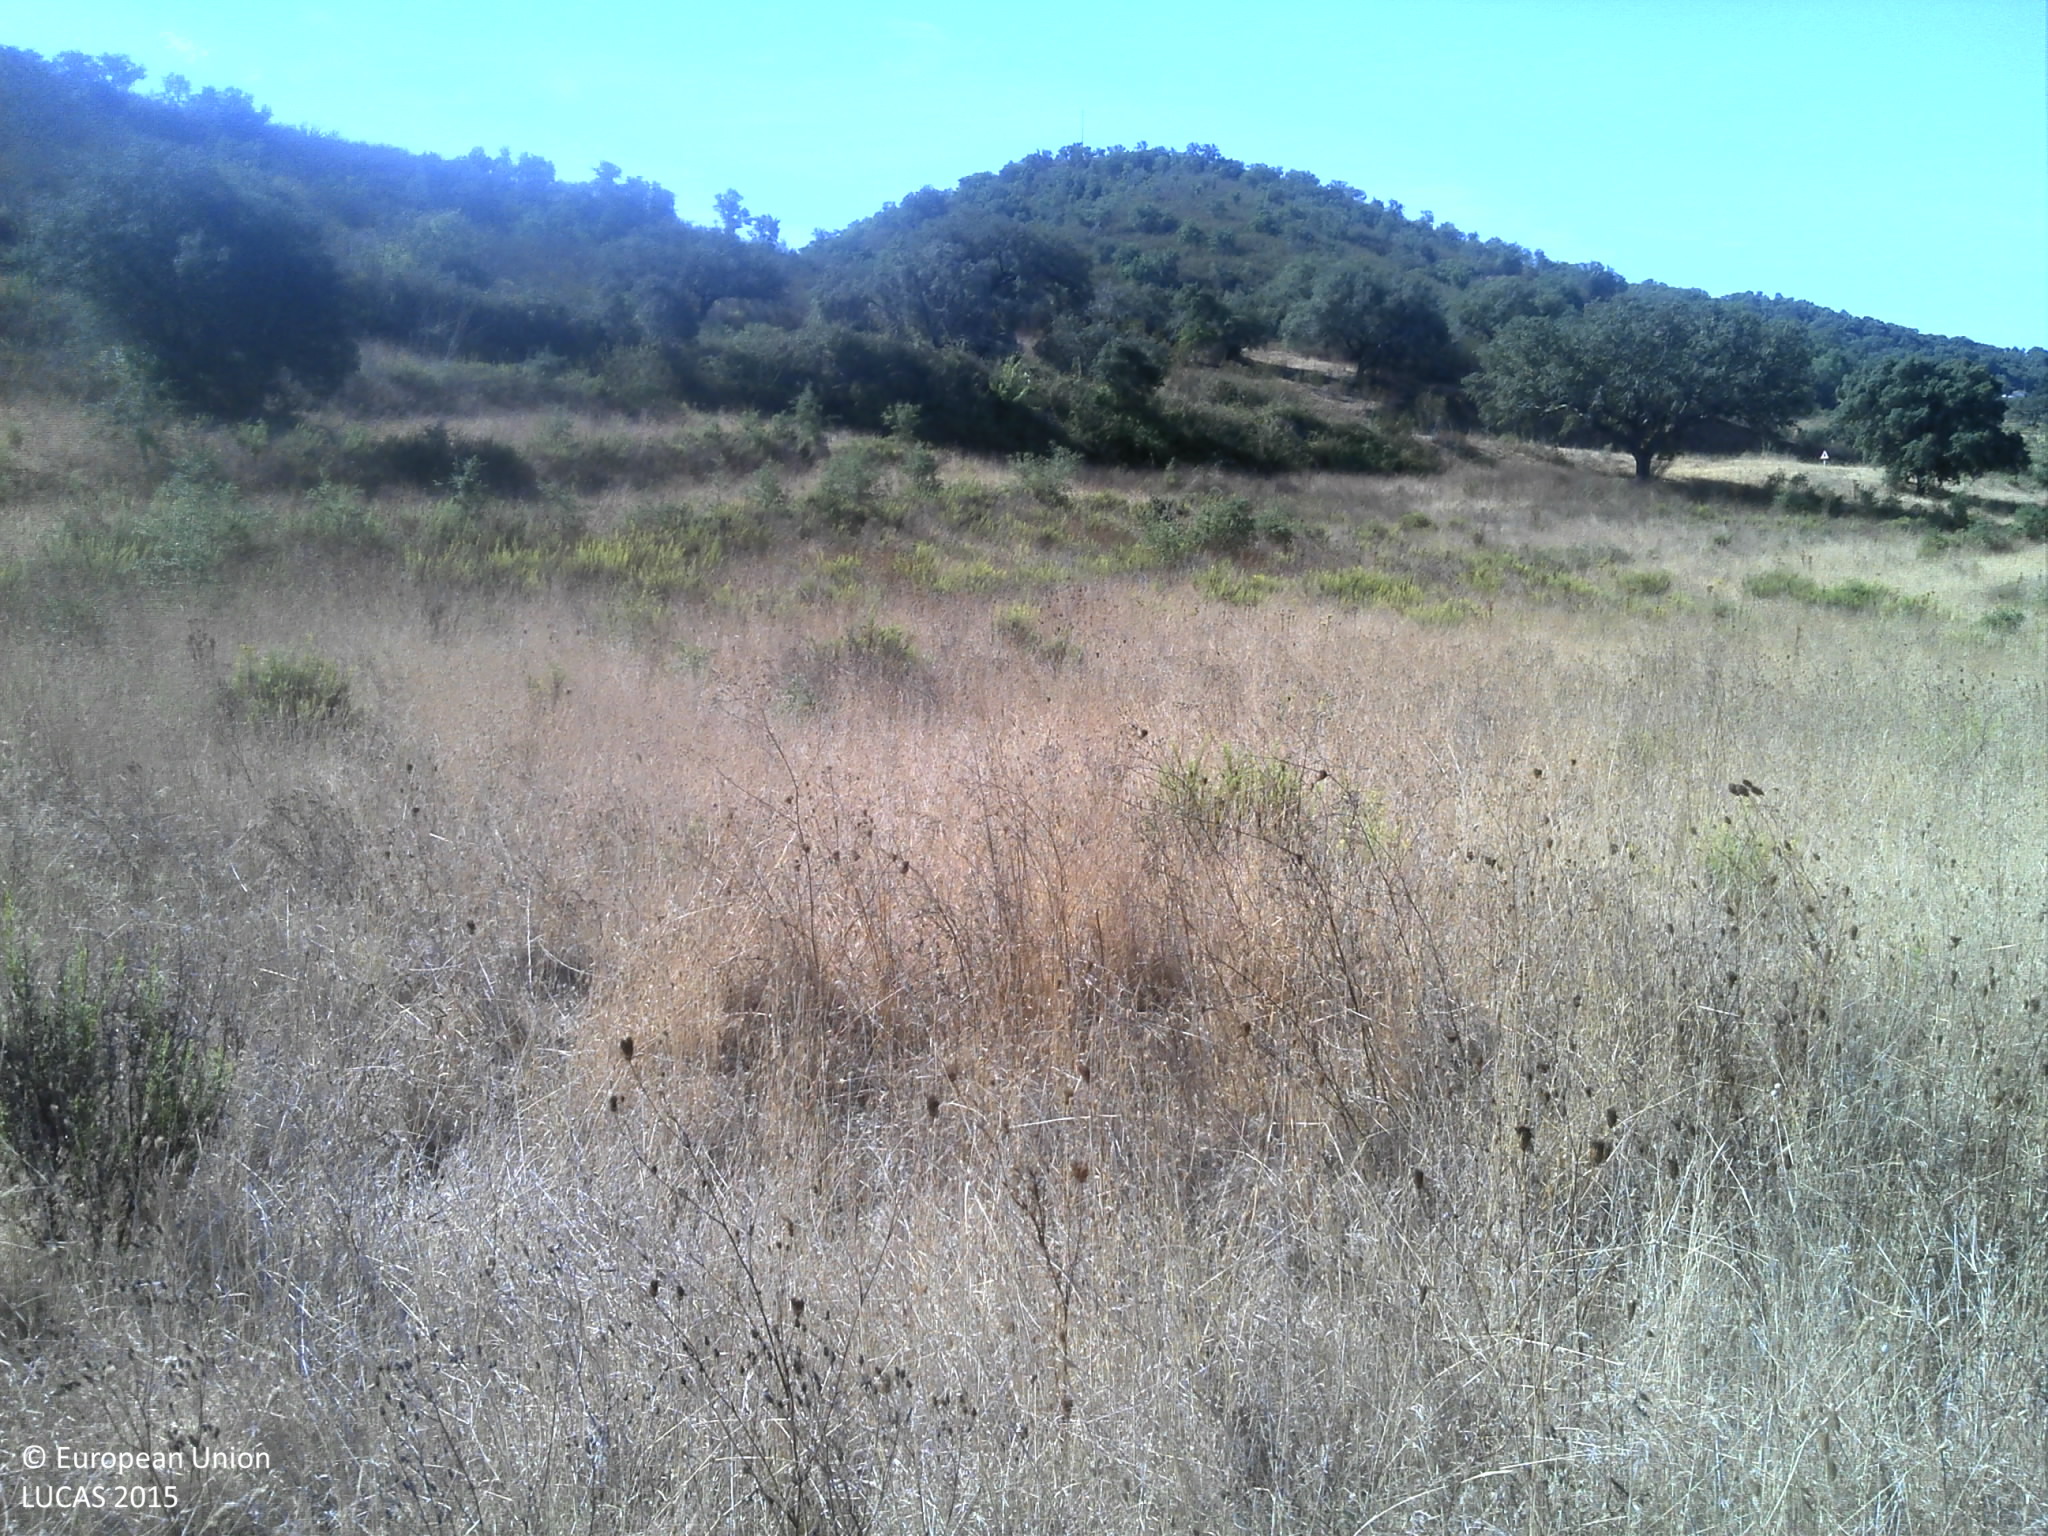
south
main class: Grassland
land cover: Grassland without tree/shrub cover
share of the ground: > 75 %
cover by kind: herbaceous plants 75 %, unconsolidated bare surface 25 %
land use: Agriculture (excluding fallow land and kitchen gardens)
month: August
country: PT
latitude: 37.5561
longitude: -8.4500
